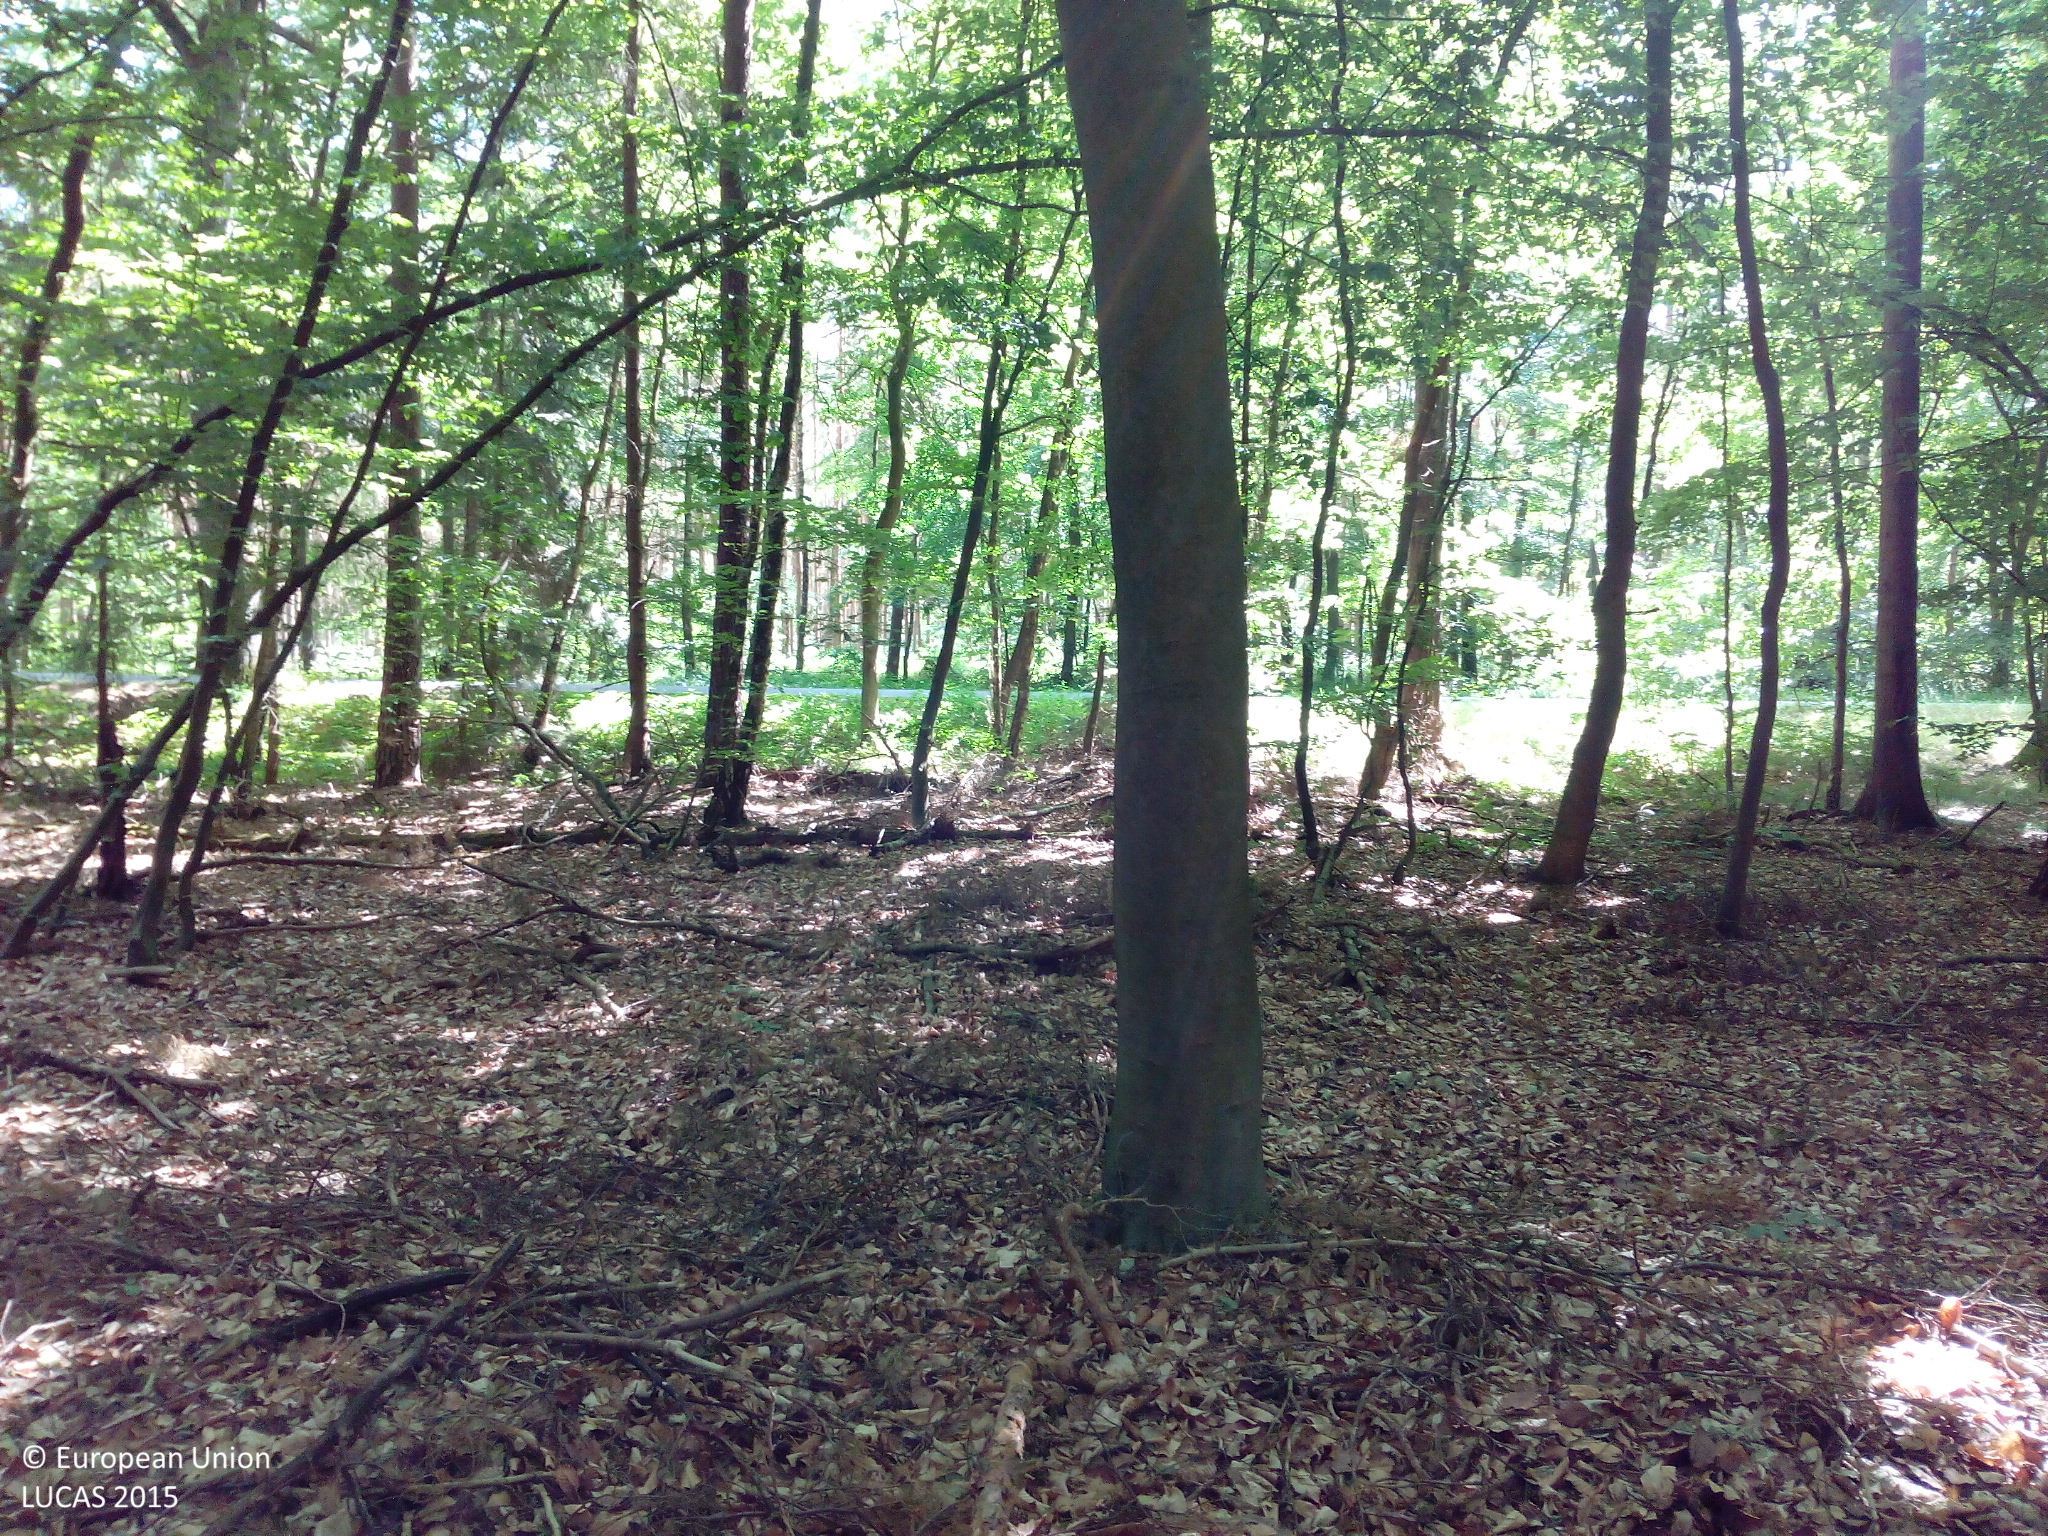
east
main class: Woodland
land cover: Pine dominated mixed woodland
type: hemiboreal forest and nemoral coniferous forest and mixed broadleaved-coniferous forest
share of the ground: > 75 %
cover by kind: coniferous forest trees 50 %, broadleaved forest trees 40 %, unconsolidated bare surface 10 %
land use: Forestry
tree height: > 5 m
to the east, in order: Pine dominated mixed woodland; Paved roads, cycling and walking lanes; Pine dominated mixed woodland; Tracks; Pine dominated coniferous woodland; Tracks; Spruce dominated coniferous woodland
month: June
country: DE
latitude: 53.5526
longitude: 11.6446
